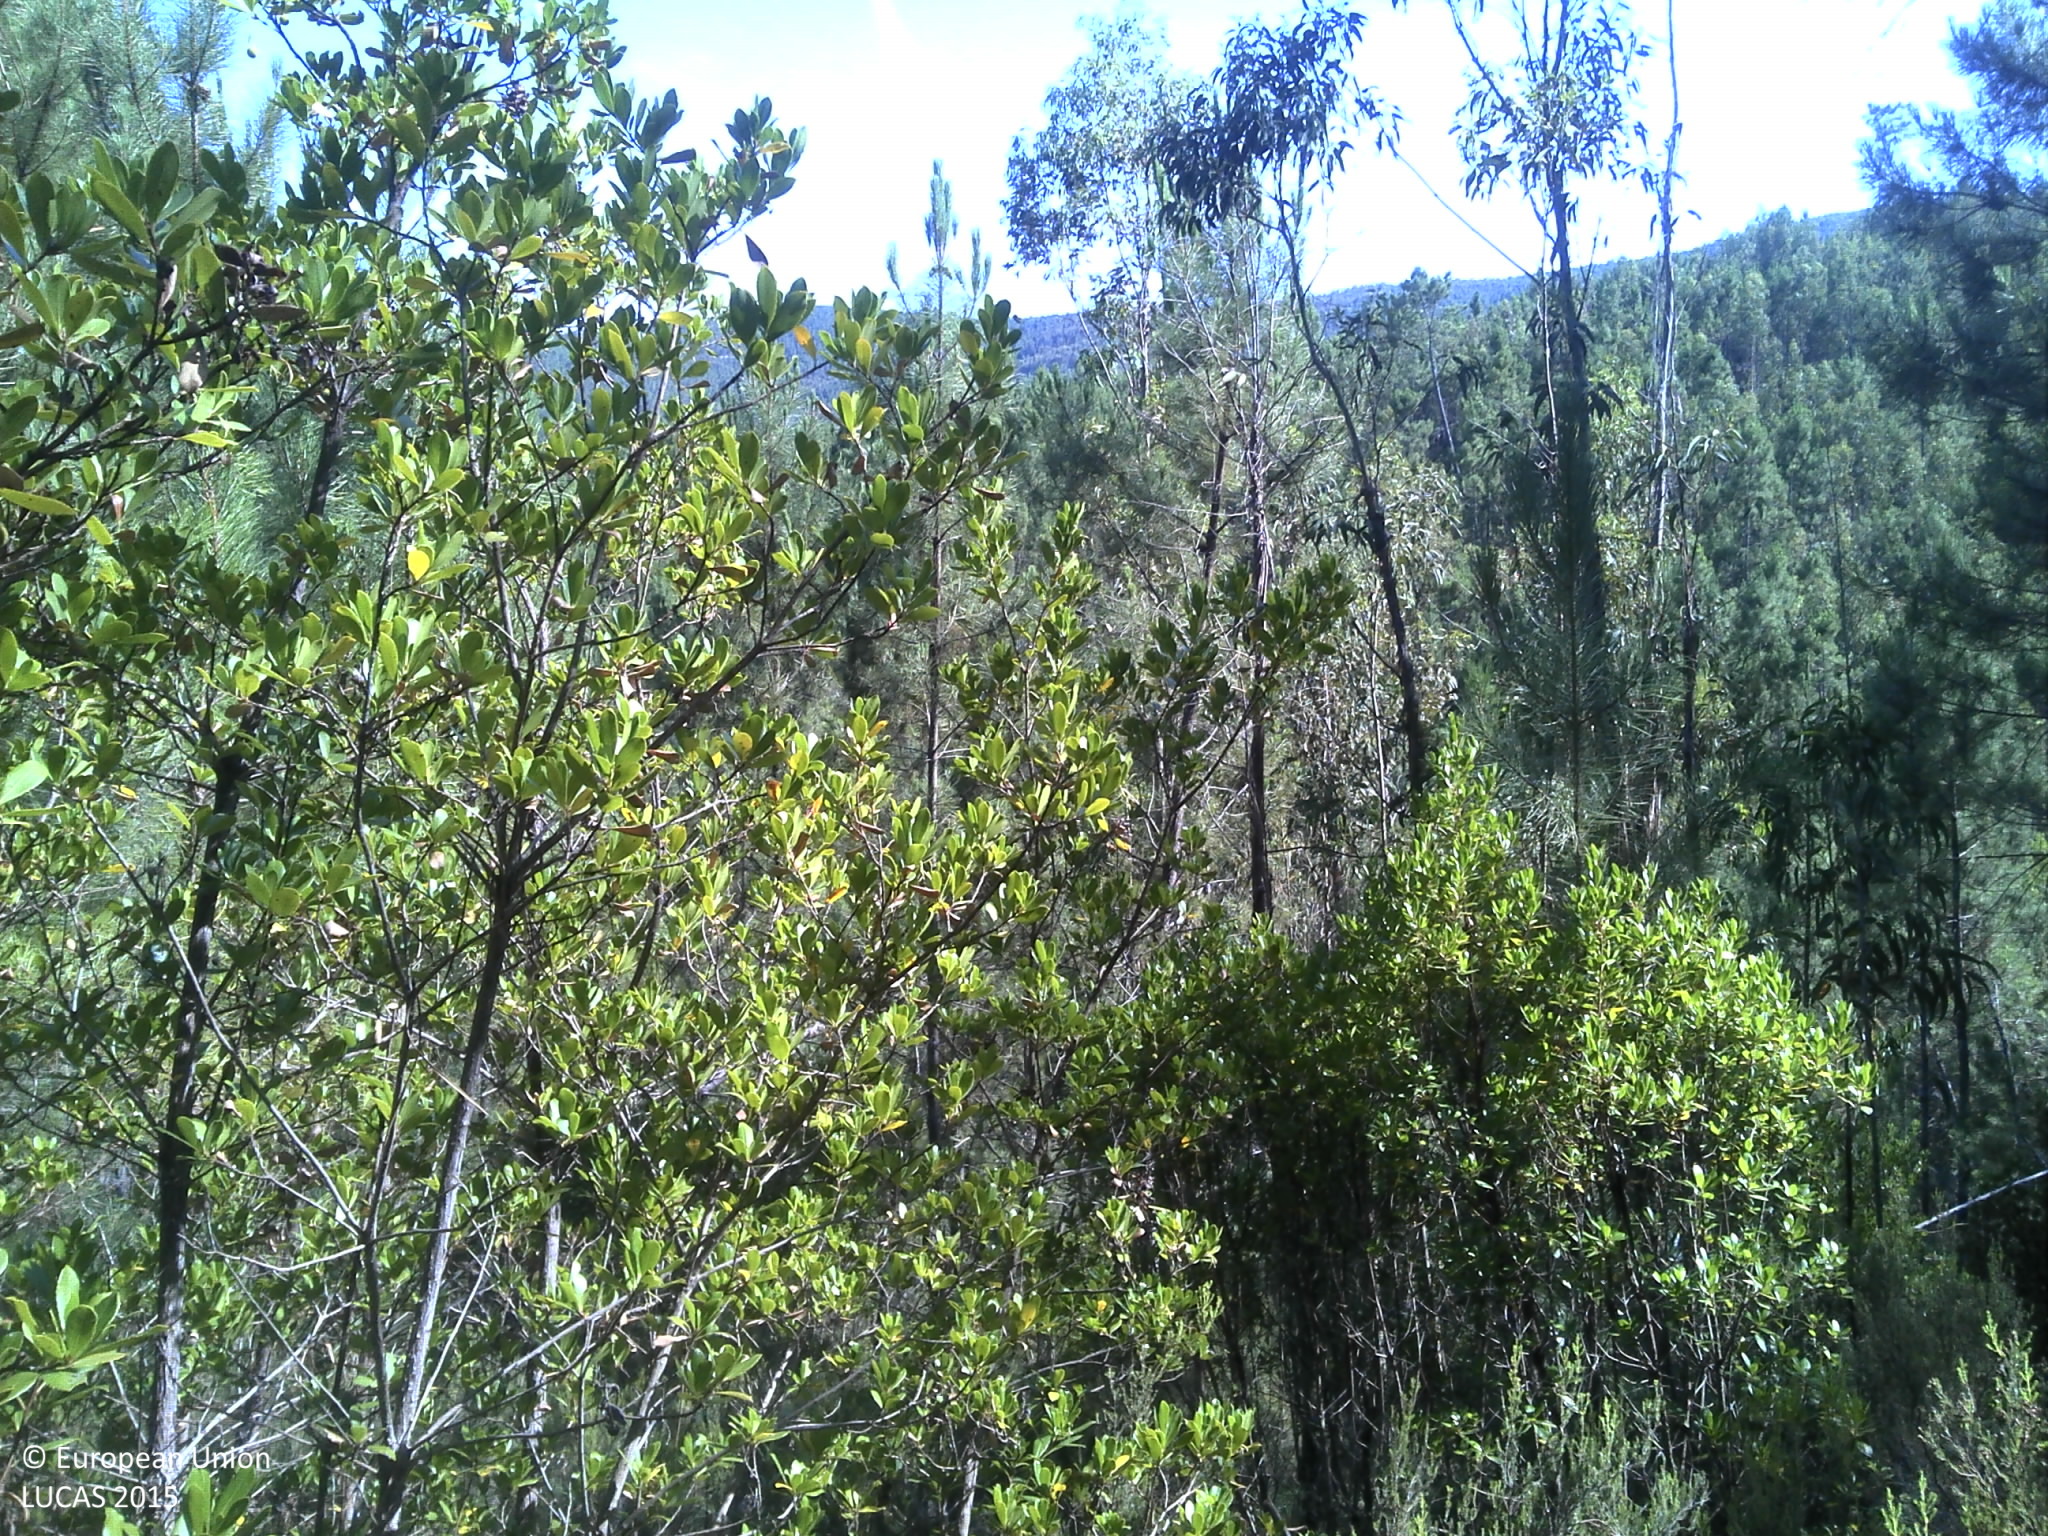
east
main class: Woodland
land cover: Pine dominated coniferous woodland
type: coniferous forest of the mediterranean region
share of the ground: 25 - 50 %
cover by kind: coniferous forest trees 50 %, shrubs 30 %, unconsolidated bare surface 20 %
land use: Forestry
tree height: > 5 m
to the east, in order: Pine dominated coniferous woodland; Tracks; Pine dominated coniferous woodland; Tracks; Shrubland with sparse tree cover; Broadleaved woodland; Rivers and streams; Broadleaved woodland
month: July
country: PT
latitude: 39.9996
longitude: -7.8568
